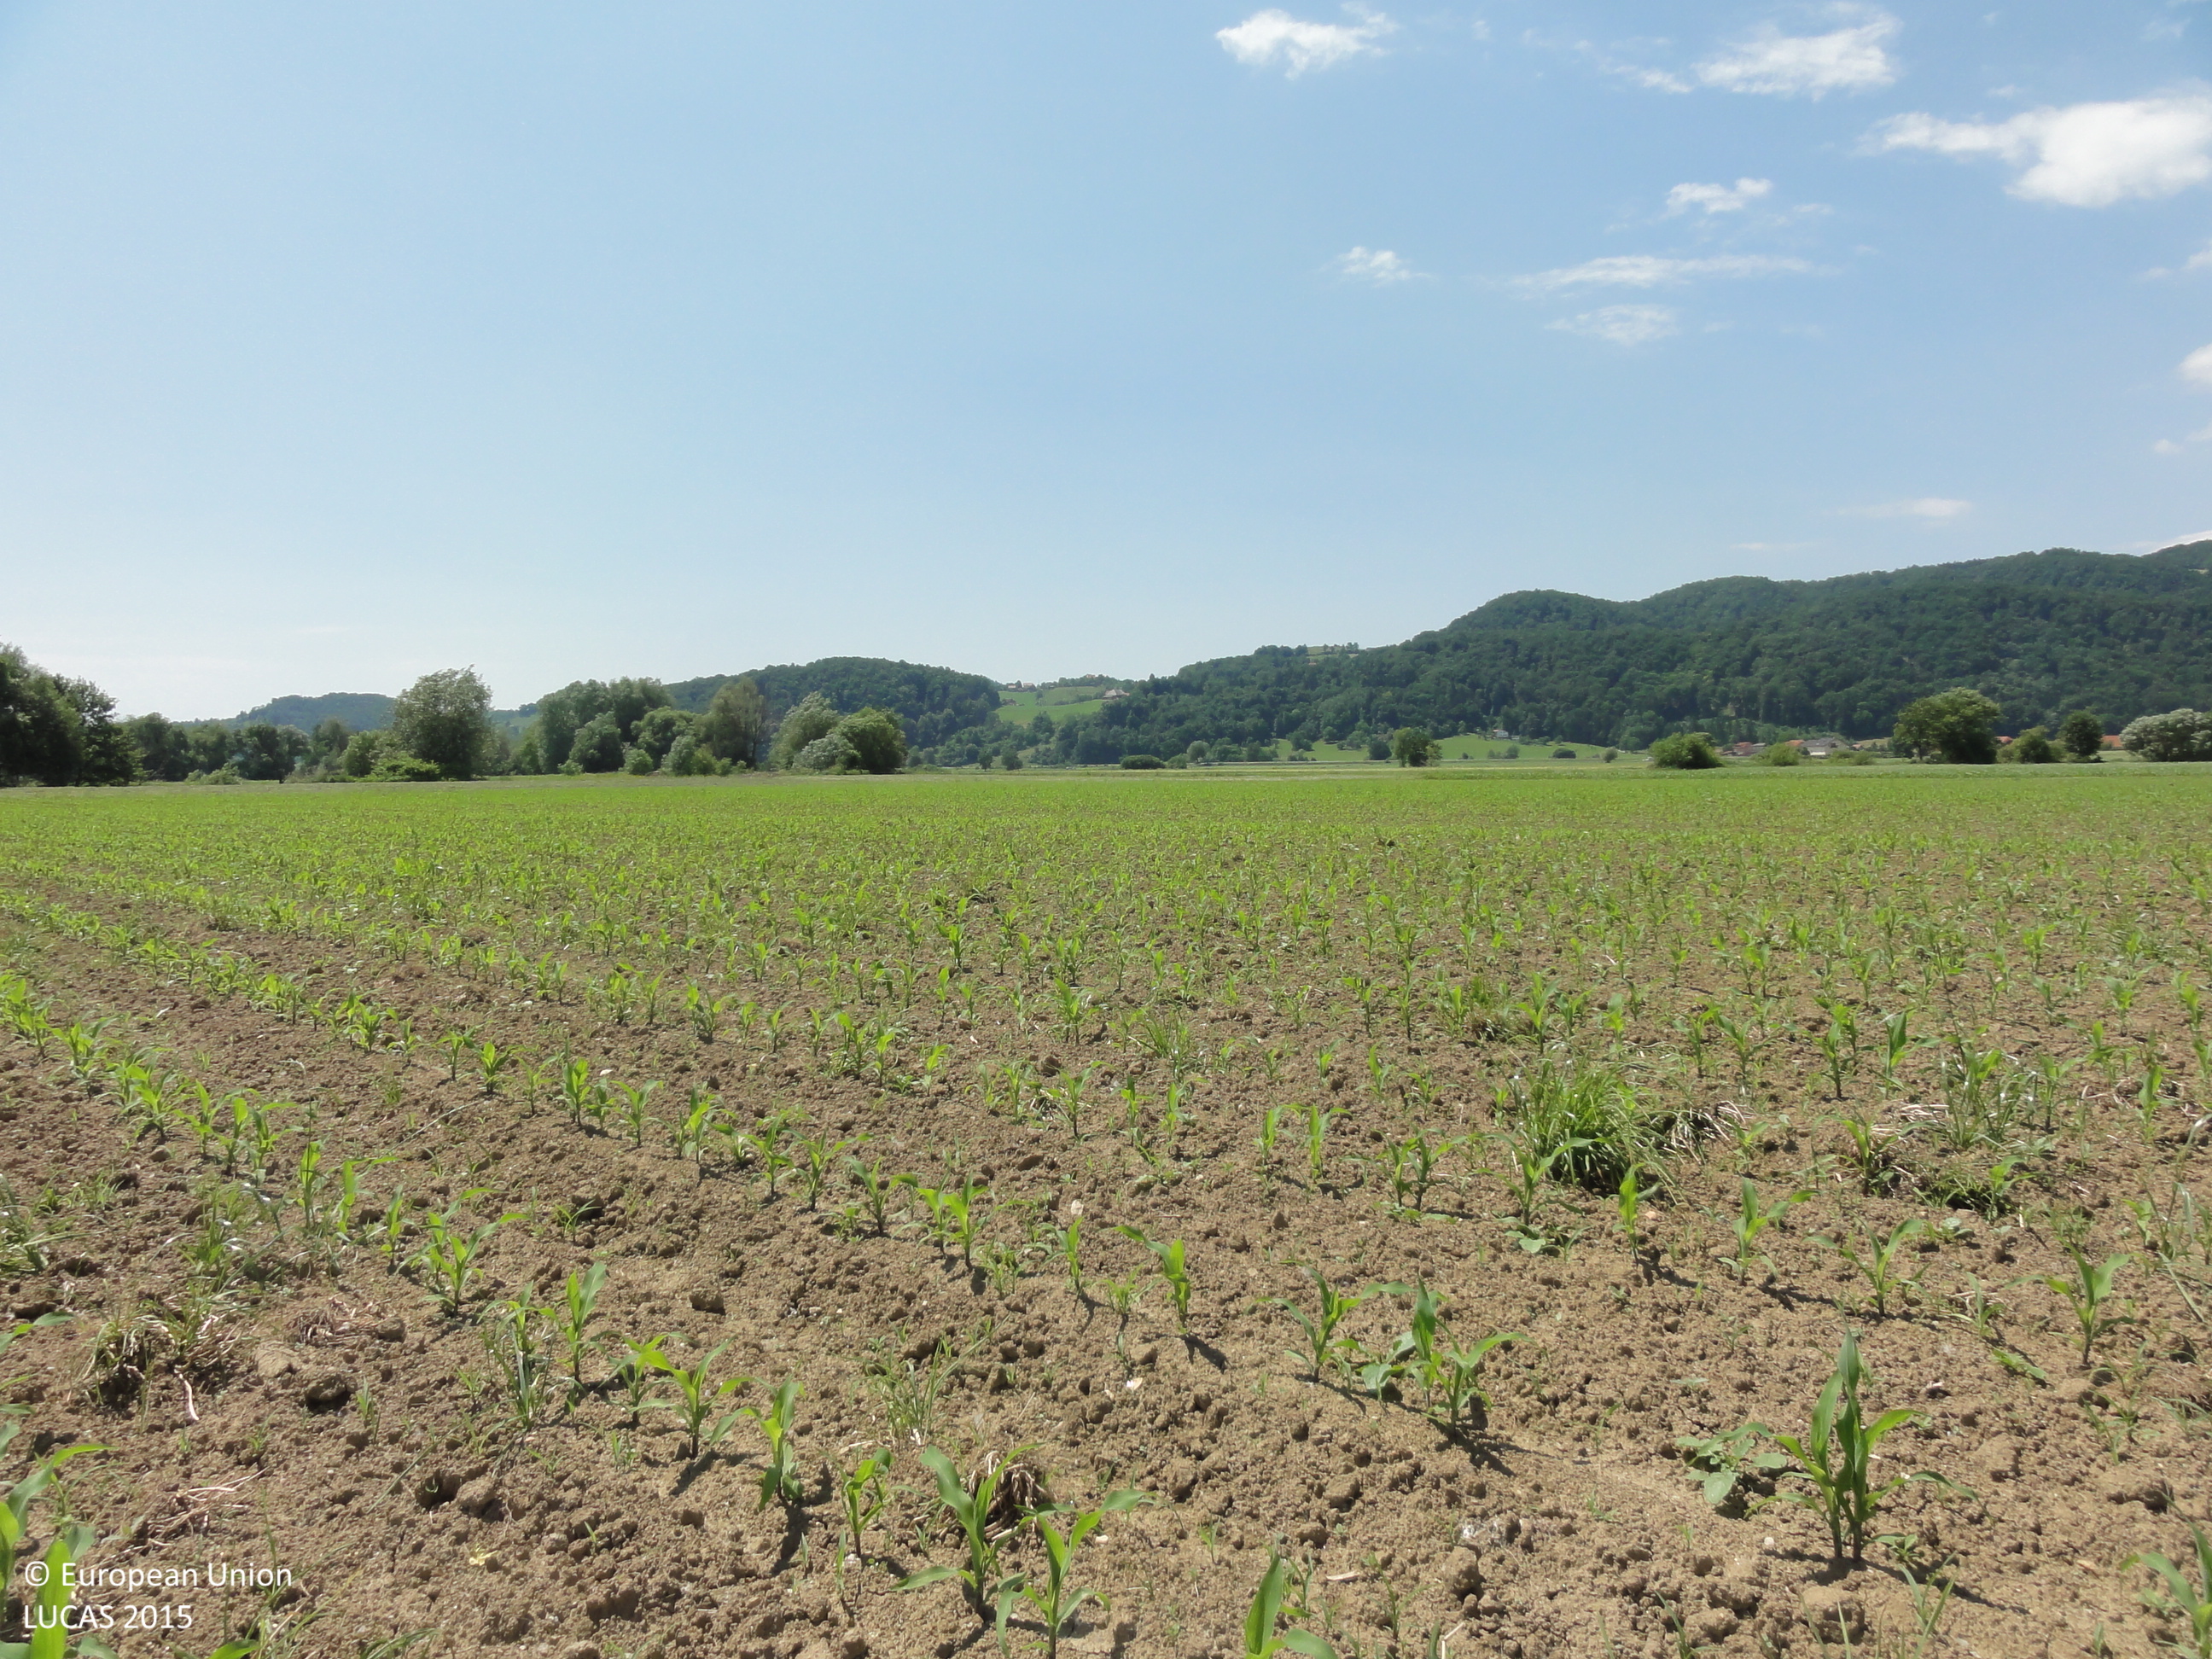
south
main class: Cropland
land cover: Maize
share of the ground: 10 - 25 %
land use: Agriculture (excluding fallow land and kitchen gardens)
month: June
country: SI
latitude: 46.3184
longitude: 15.4918
